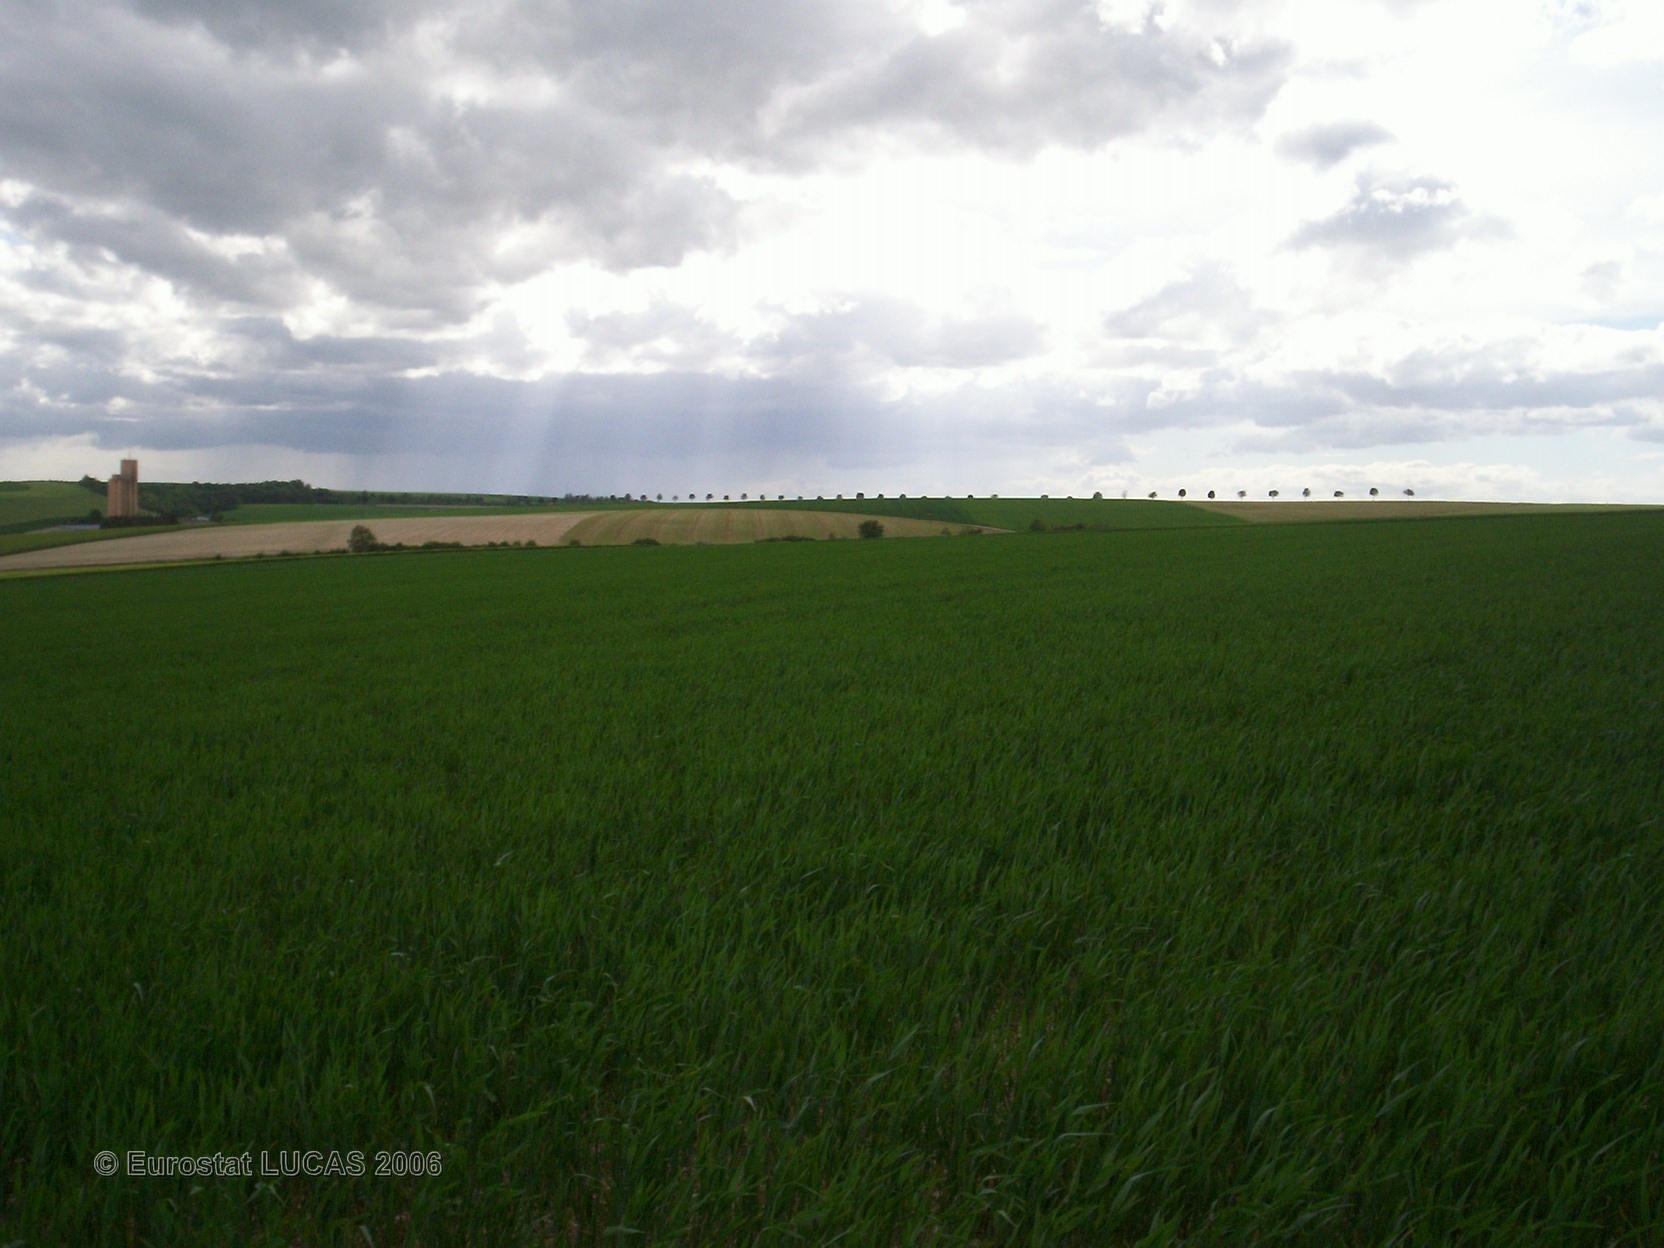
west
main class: Cropland
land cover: Common wheat
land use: Agriculture (excluding fallow land and kitchen gardens)
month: May
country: FR
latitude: 49.3527
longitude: 4.5863
